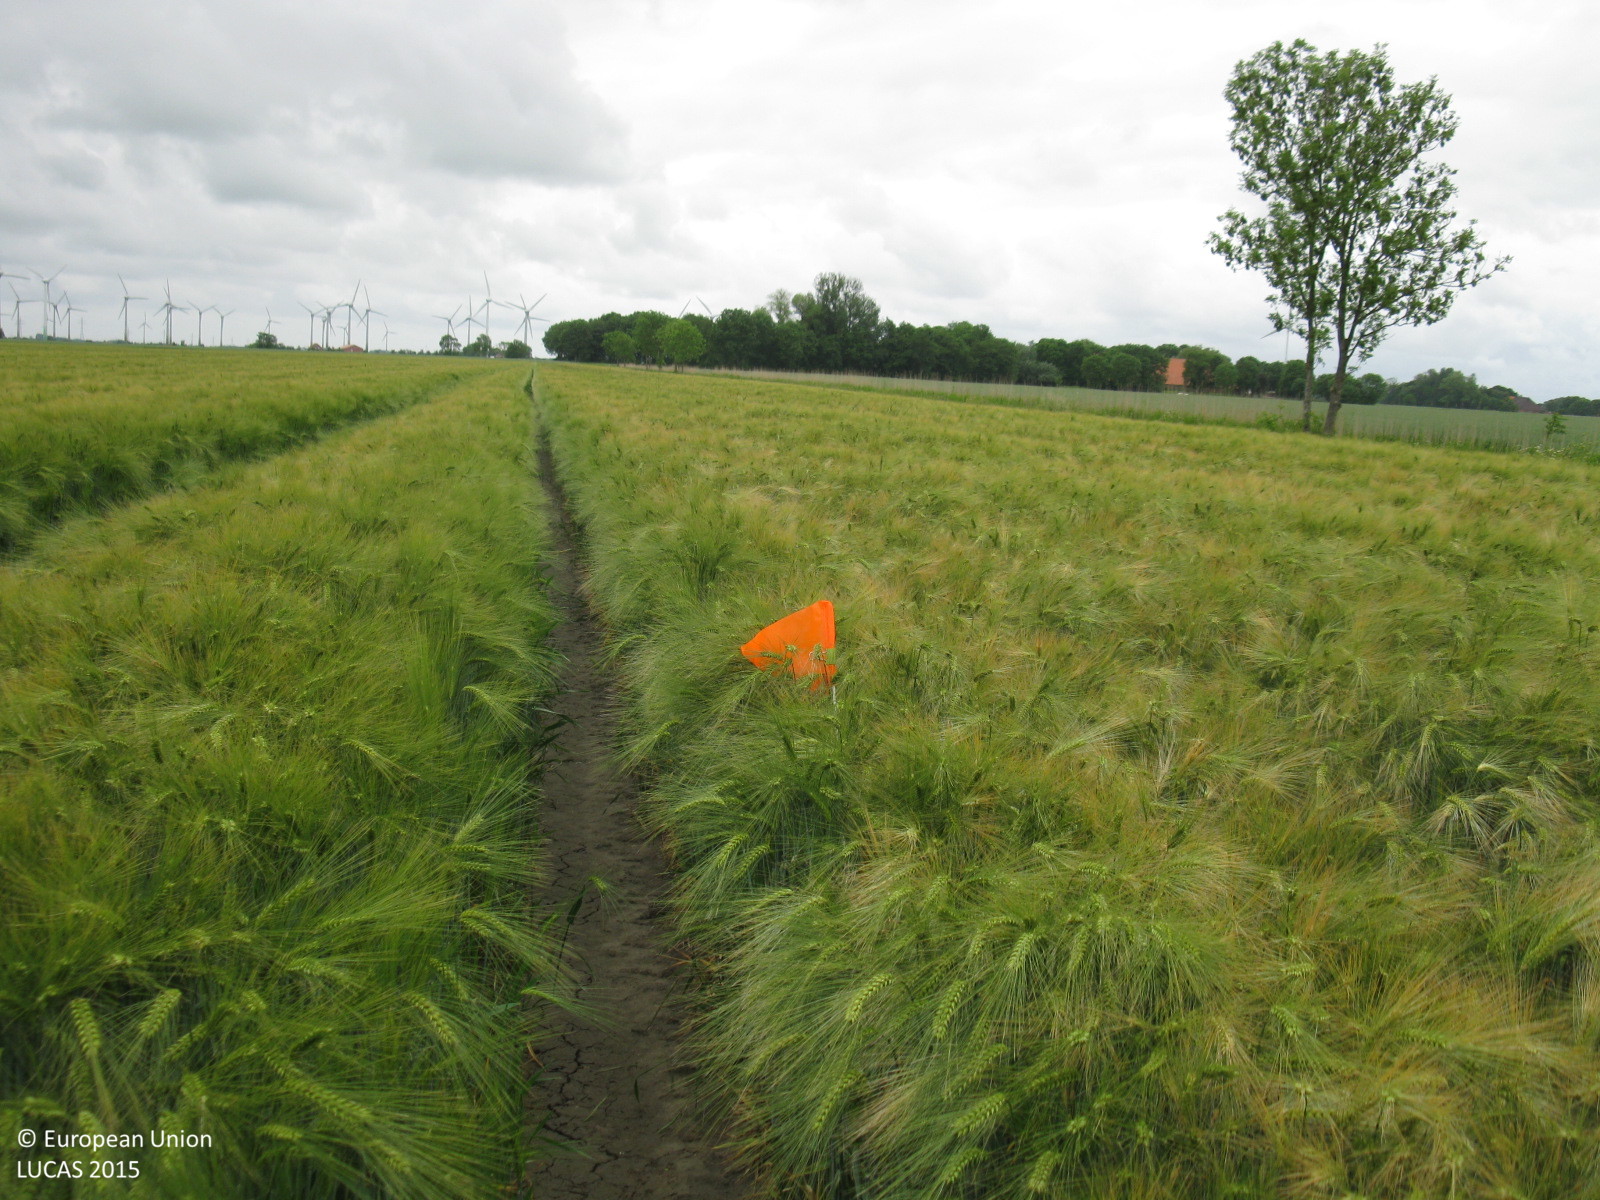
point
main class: Cropland
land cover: Barley
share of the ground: > 75 %
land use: Agriculture (excluding fallow land and kitchen gardens)
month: June
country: DE
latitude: 53.6415
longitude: 7.2932
